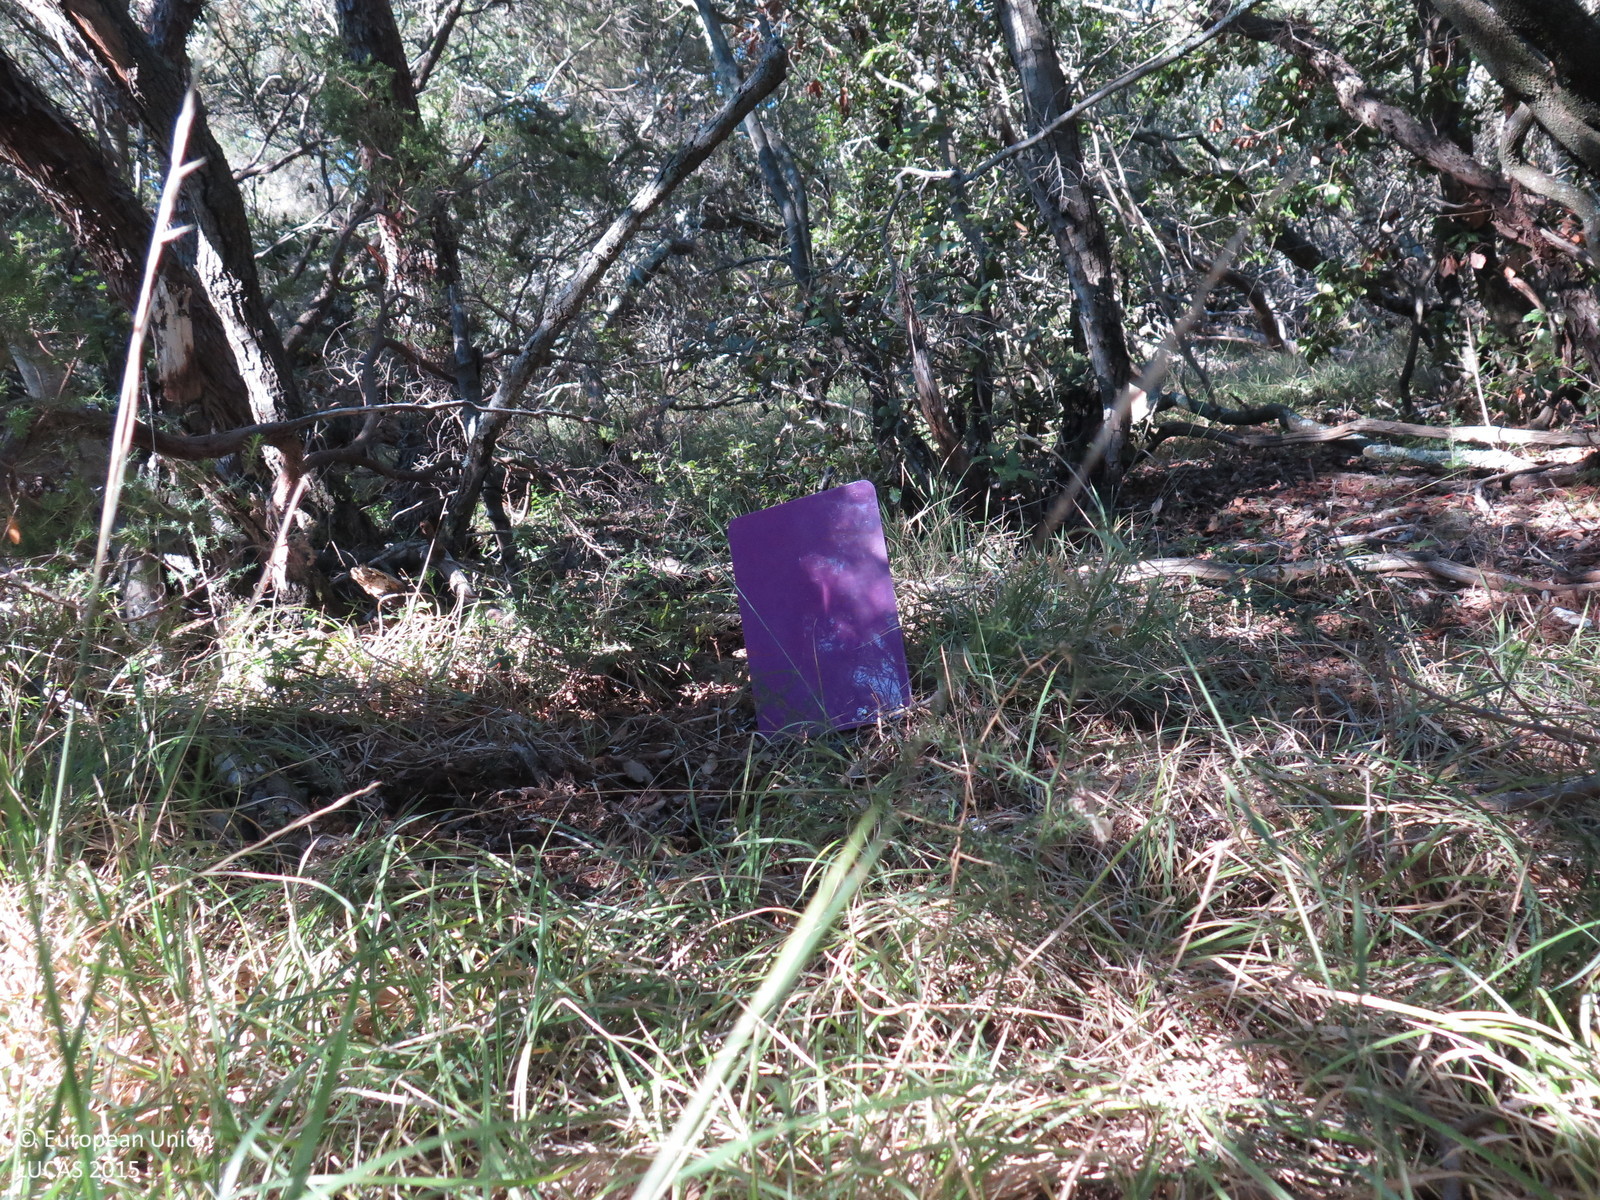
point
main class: Woodland
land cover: Broadleaved woodland
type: thermophilous deciduous forest
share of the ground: > 75 %
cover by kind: broadleaved forest trees 90 %, shrubs 5 %, herbaceous plants 5 %
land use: Semi-natural and natural areas not in use
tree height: > 5 m
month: September
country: HR
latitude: 44.5828
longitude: 14.3888
